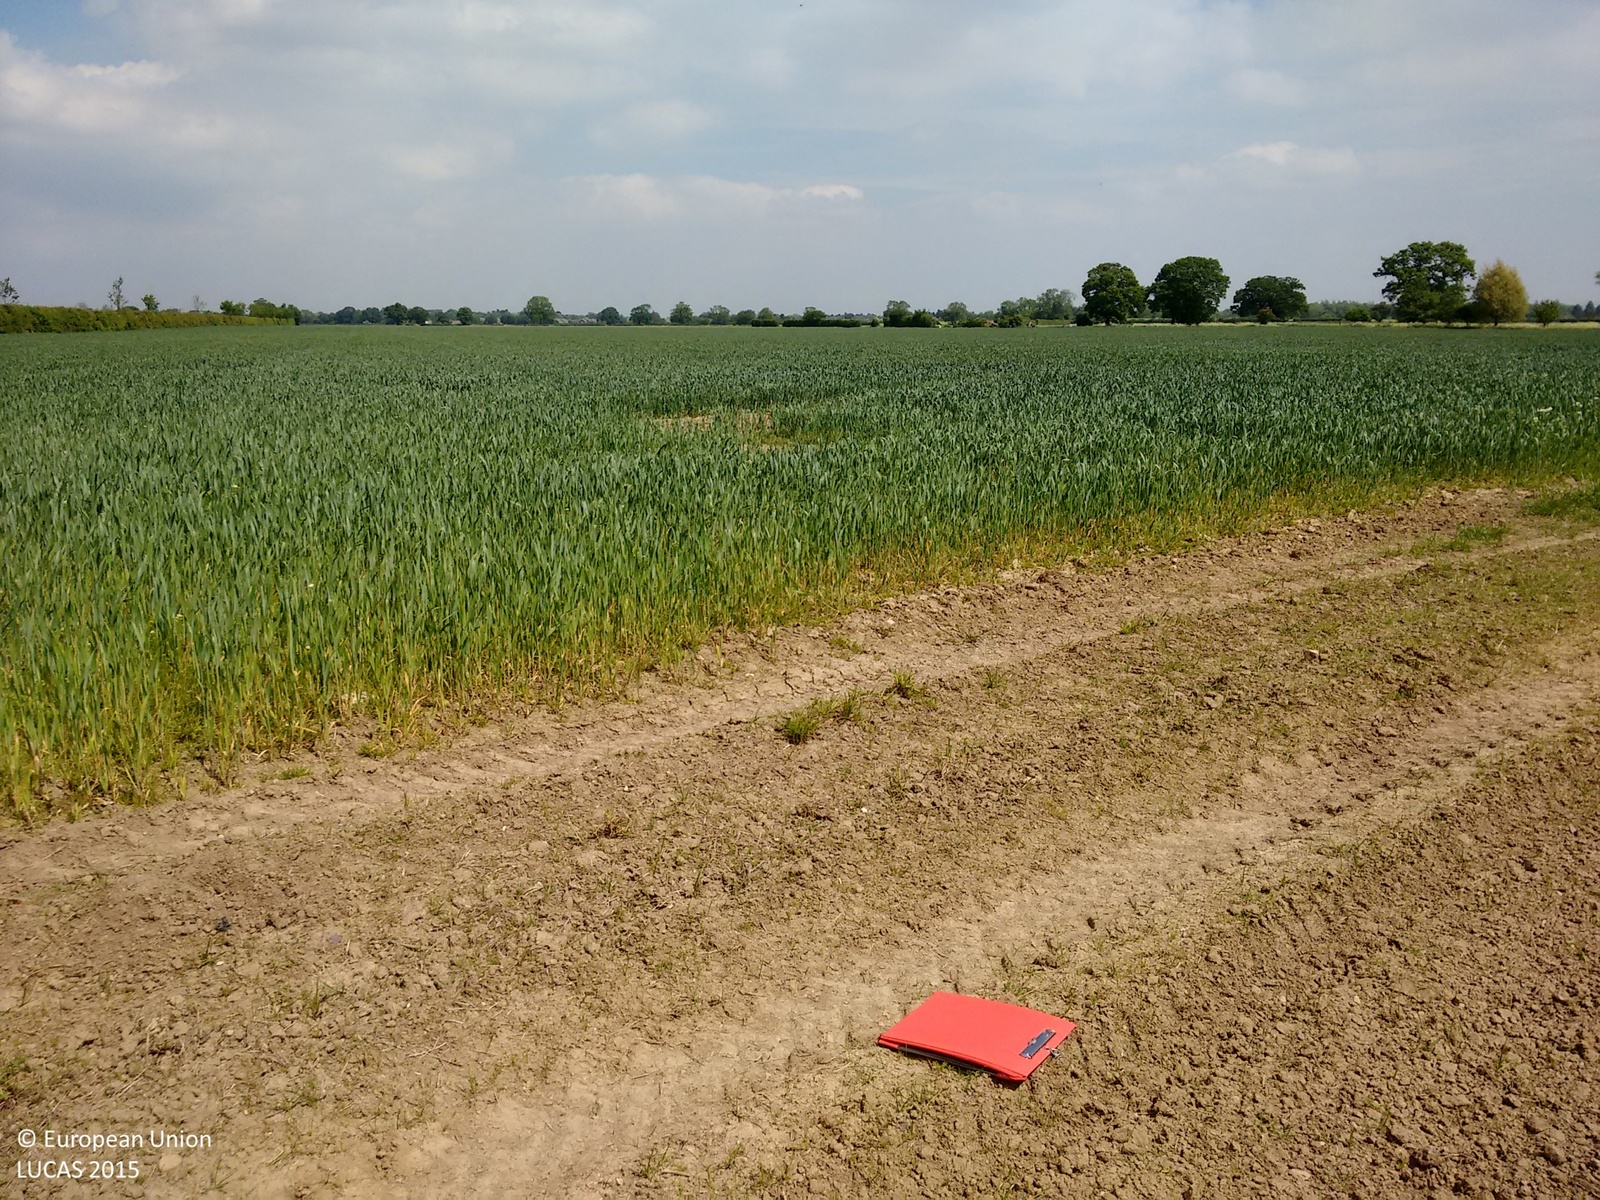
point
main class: Cropland
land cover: Common wheat
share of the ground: > 75 %
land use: Agriculture (excluding fallow land and kitchen gardens)
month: June
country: GB
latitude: 53.9057
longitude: -1.1101
